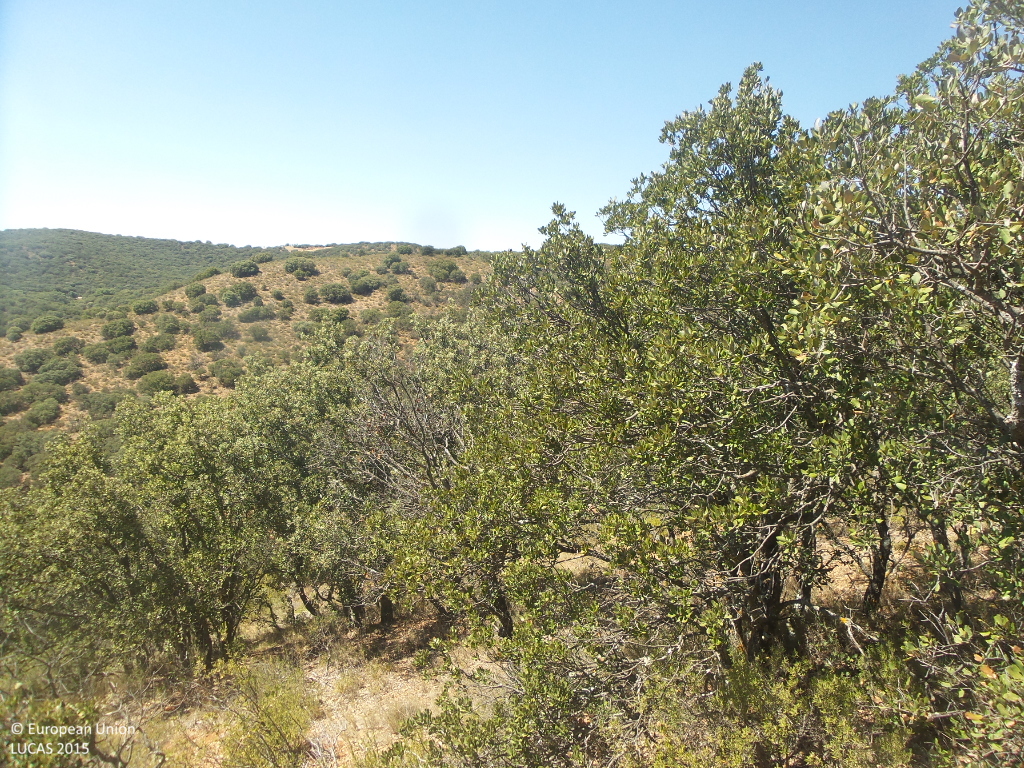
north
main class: Woodland
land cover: Broadleaved woodland
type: broadleaved evergreen forest
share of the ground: 50 - 75 %
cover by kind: broadleaved forest trees 70 %, shrubs 10 %, unconsolidated bare surface 10 %, herbaceous plants 5 %, lichens and mosses 5 %
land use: Semi-natural and natural areas not in use
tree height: < 5 m
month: July
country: ES
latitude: 41.3641
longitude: -2.0677
